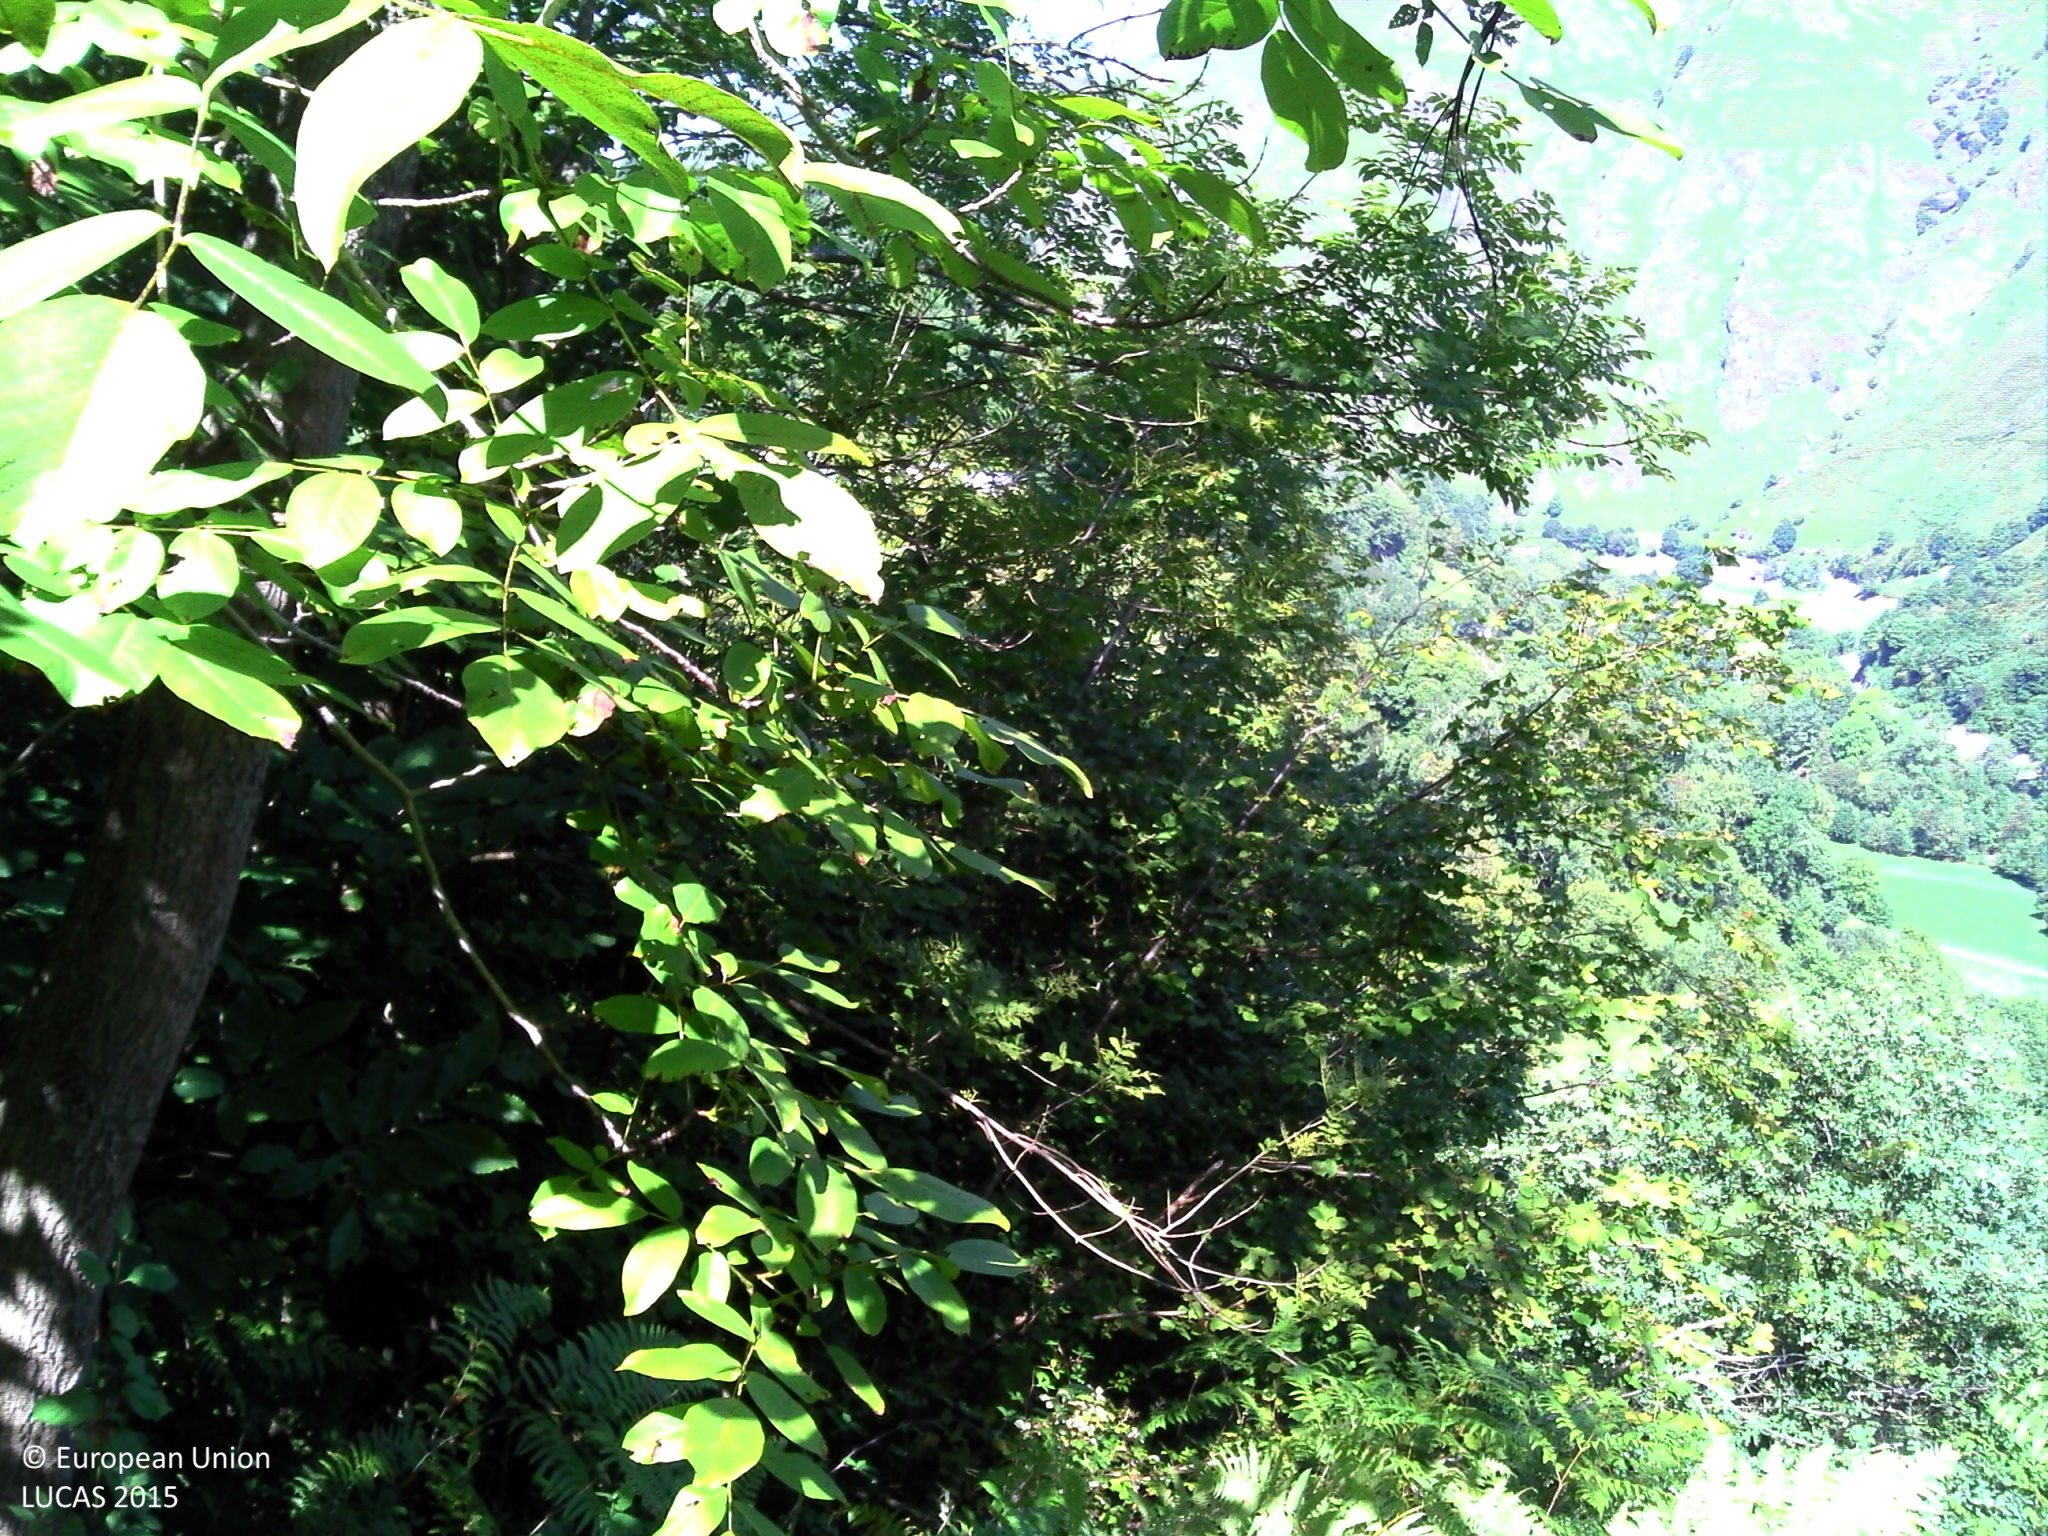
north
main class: Woodland
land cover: Broadleaved woodland
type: acidophilous oak and oak-birch forest
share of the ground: 50 - 75 %
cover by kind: broadleaved forest trees 60 %, herbaceous plants 30 %, shrubs 5 %, consolidated bare surface 5 %
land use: Forestry
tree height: > 5 m
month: September
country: FR
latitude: 43.0141
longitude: -0.8673
